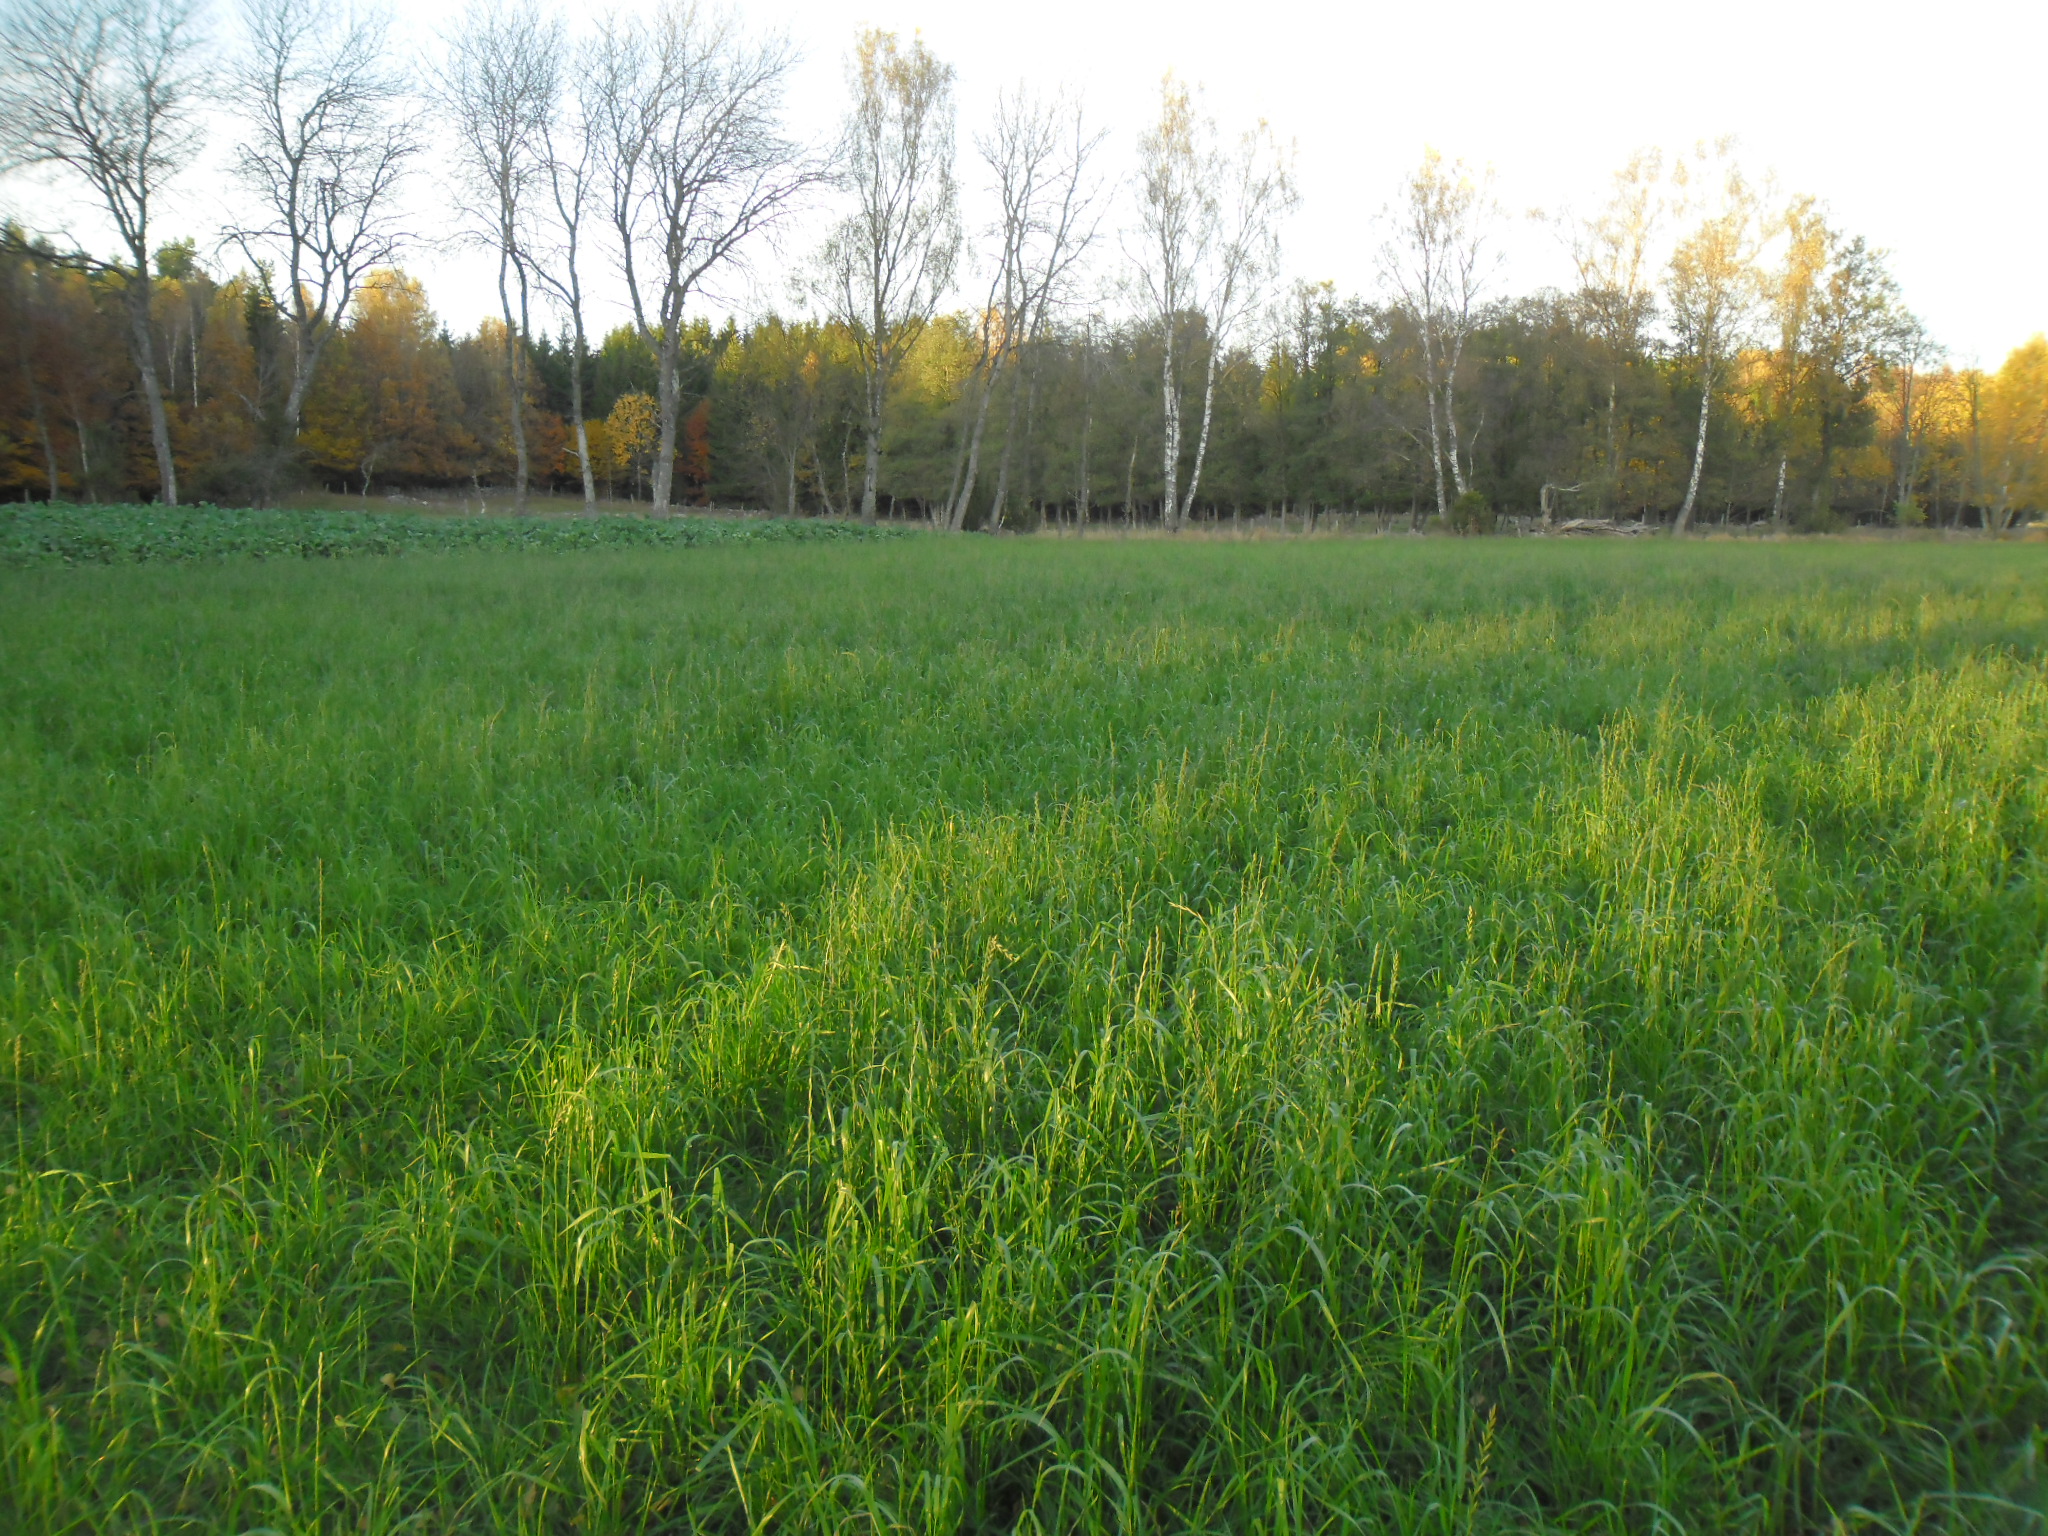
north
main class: Grassland
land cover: Grassland without tree/shrub cover
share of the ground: > 75 %
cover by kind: herbaceous plants 100 %
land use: Agriculture (excluding fallow land and kitchen gardens)
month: October
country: SE
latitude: 56.2059
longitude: 13.7213
